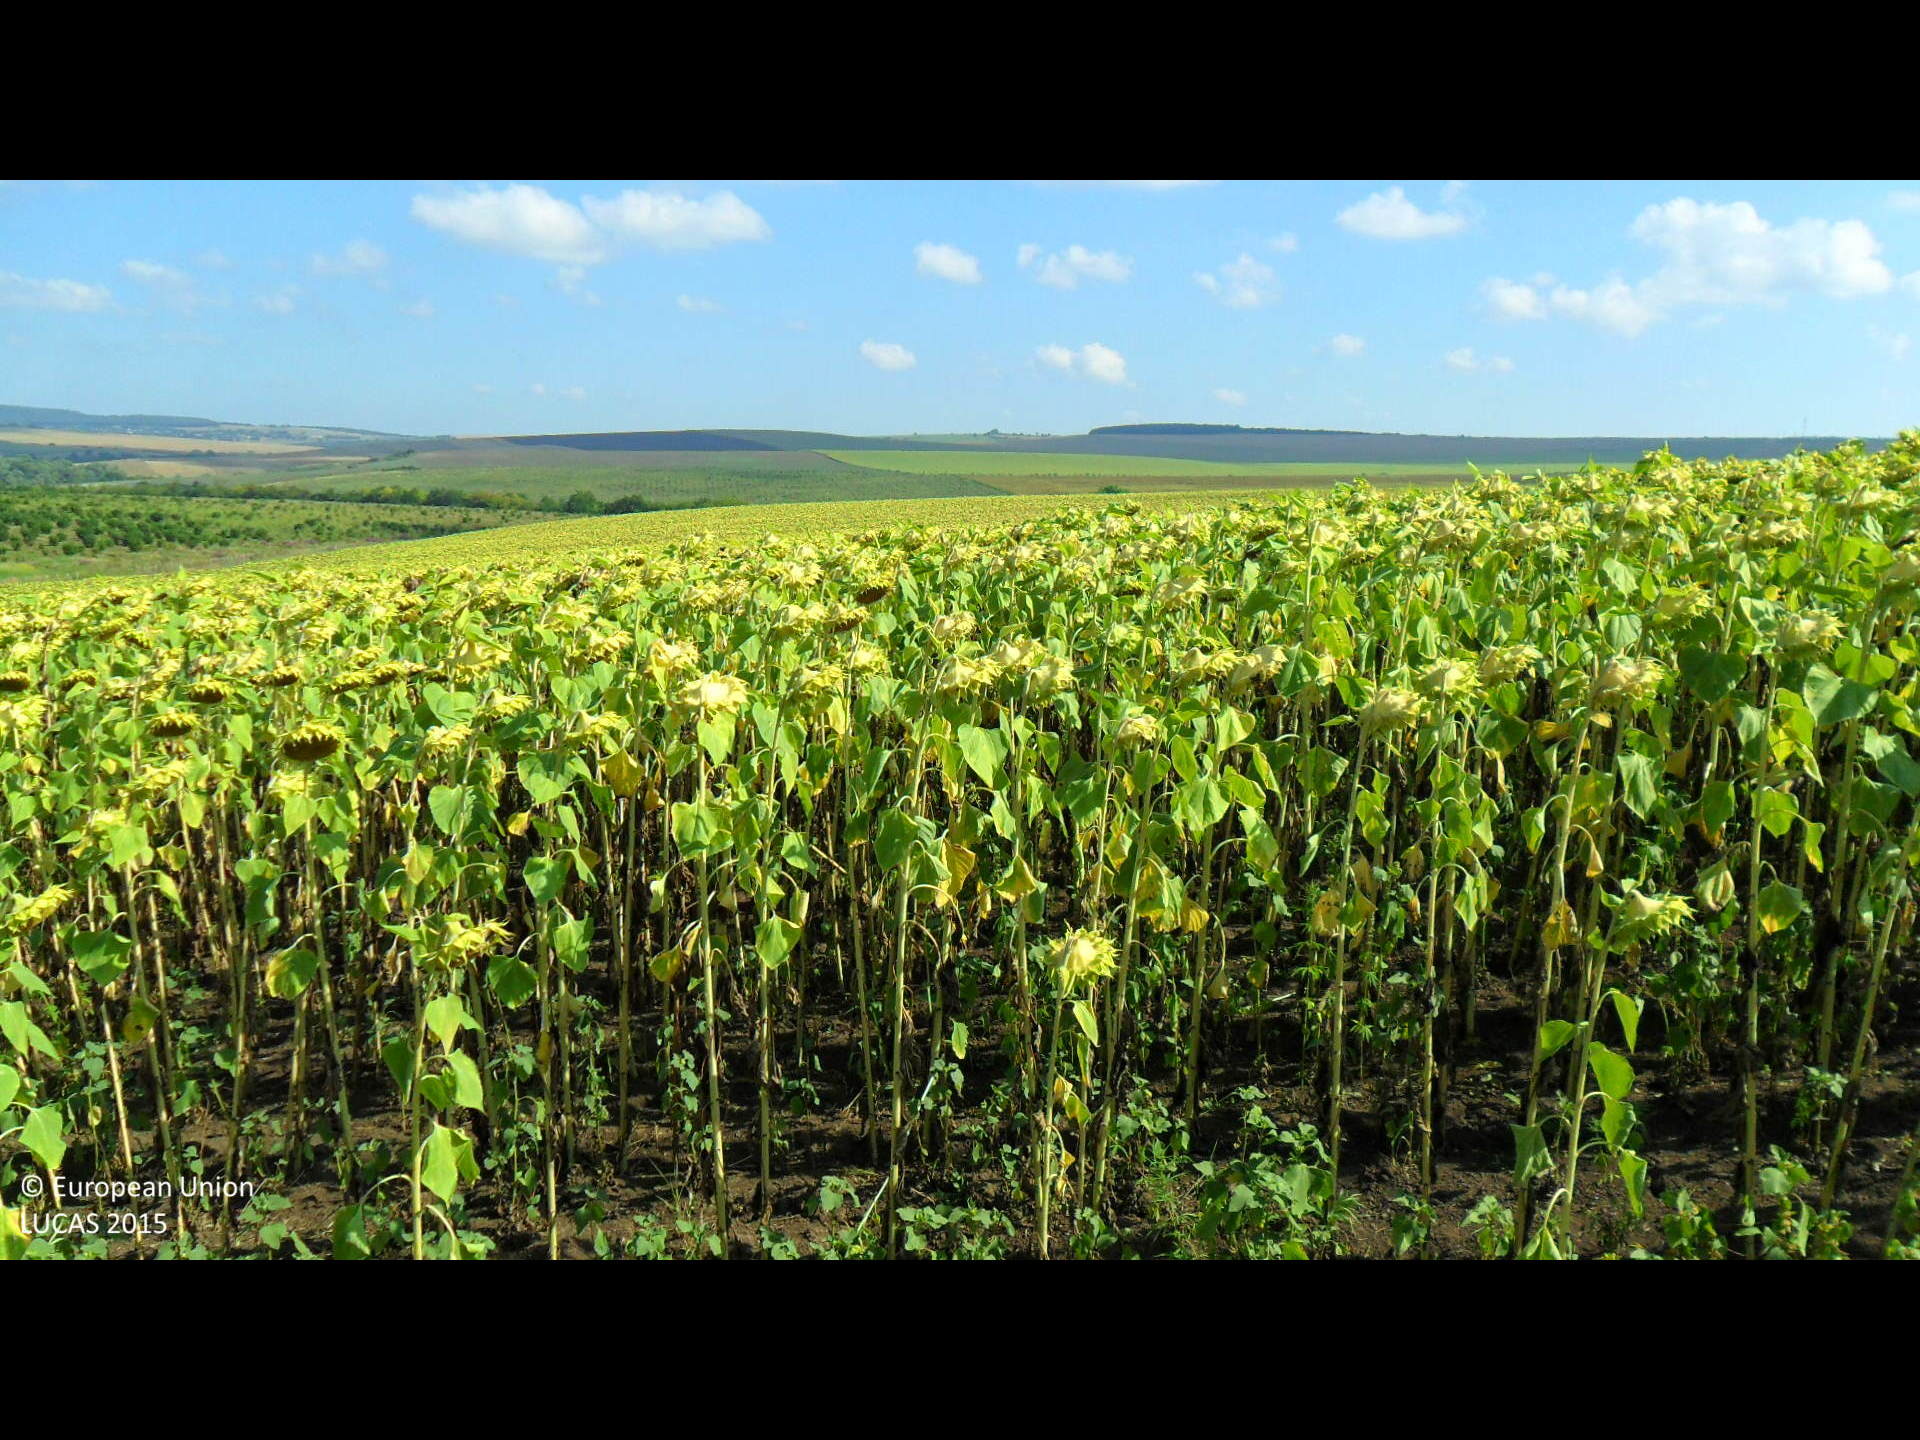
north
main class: Cropland
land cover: Sunflower
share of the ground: > 75 %
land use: Agriculture (excluding fallow land and kitchen gardens)
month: August
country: BG
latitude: 43.3987
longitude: 26.3102
